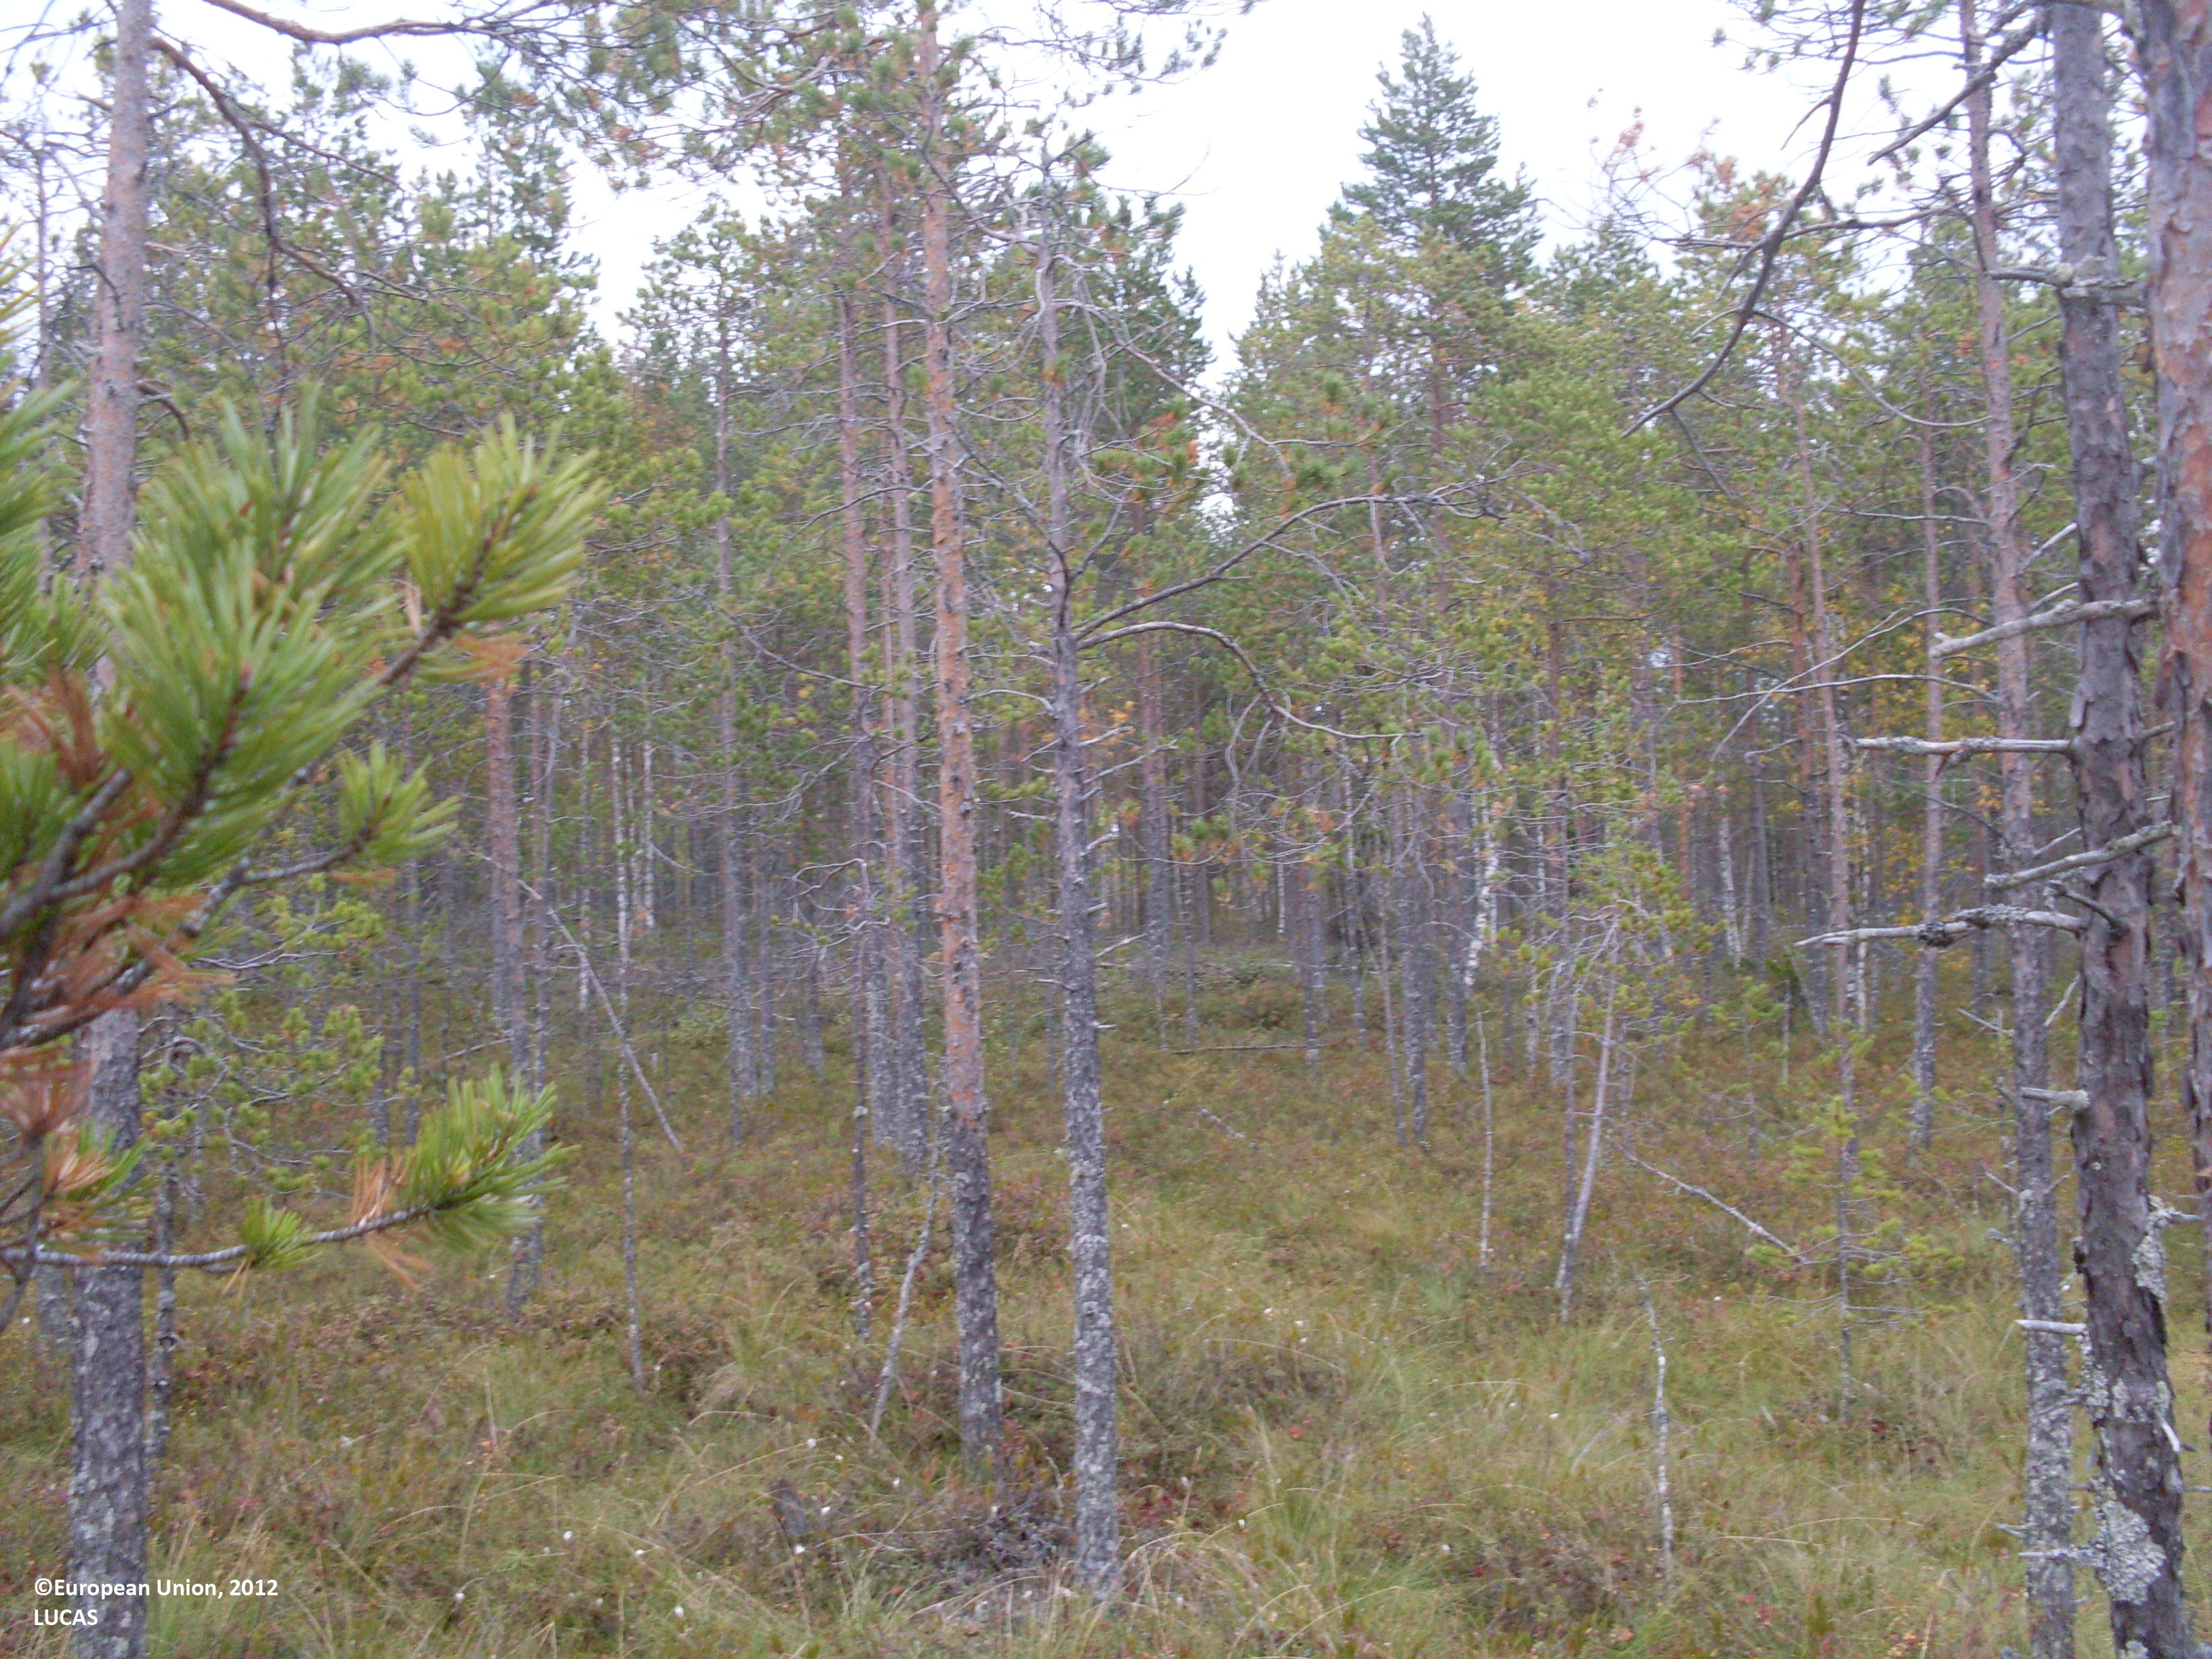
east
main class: Woodland
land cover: Pine dominated coniferous woodland
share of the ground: 10 - 25 %
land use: Semi-natural and natural areas not in use
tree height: < 5 m
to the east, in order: Pine dominated coniferous woodland
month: September
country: FI
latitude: 64.1529
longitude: 29.2666
